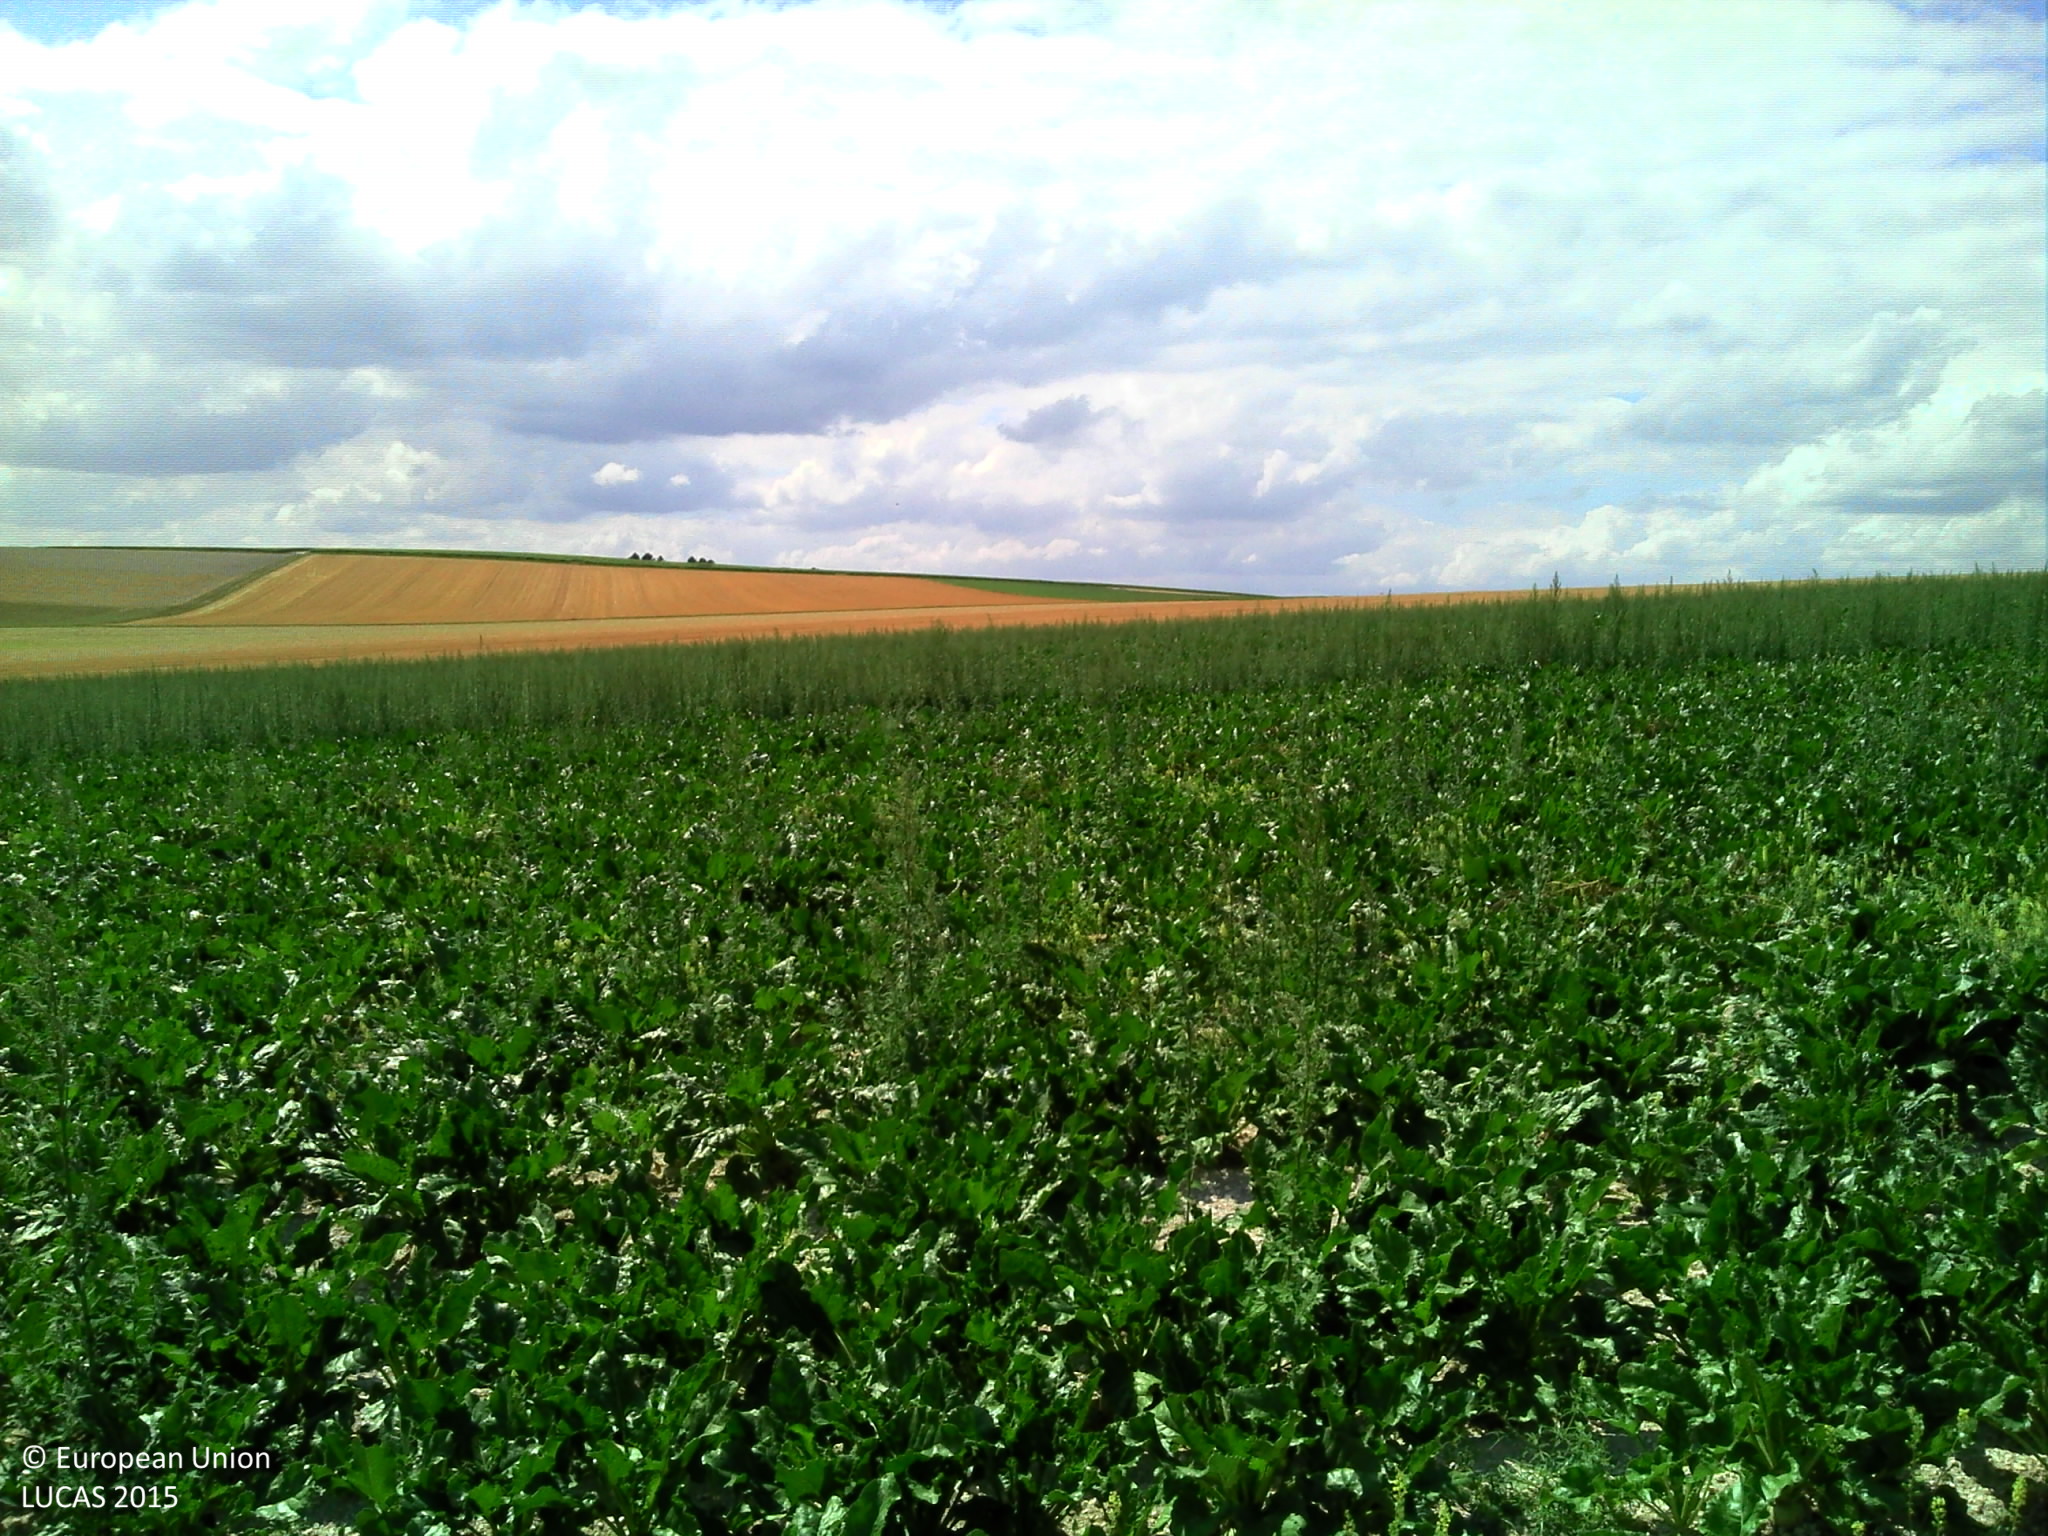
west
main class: Cropland
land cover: Sugar beet
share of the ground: > 75 %
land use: Agriculture (excluding fallow land and kitchen gardens)
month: August
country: FR
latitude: 49.0769
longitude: 4.1225
